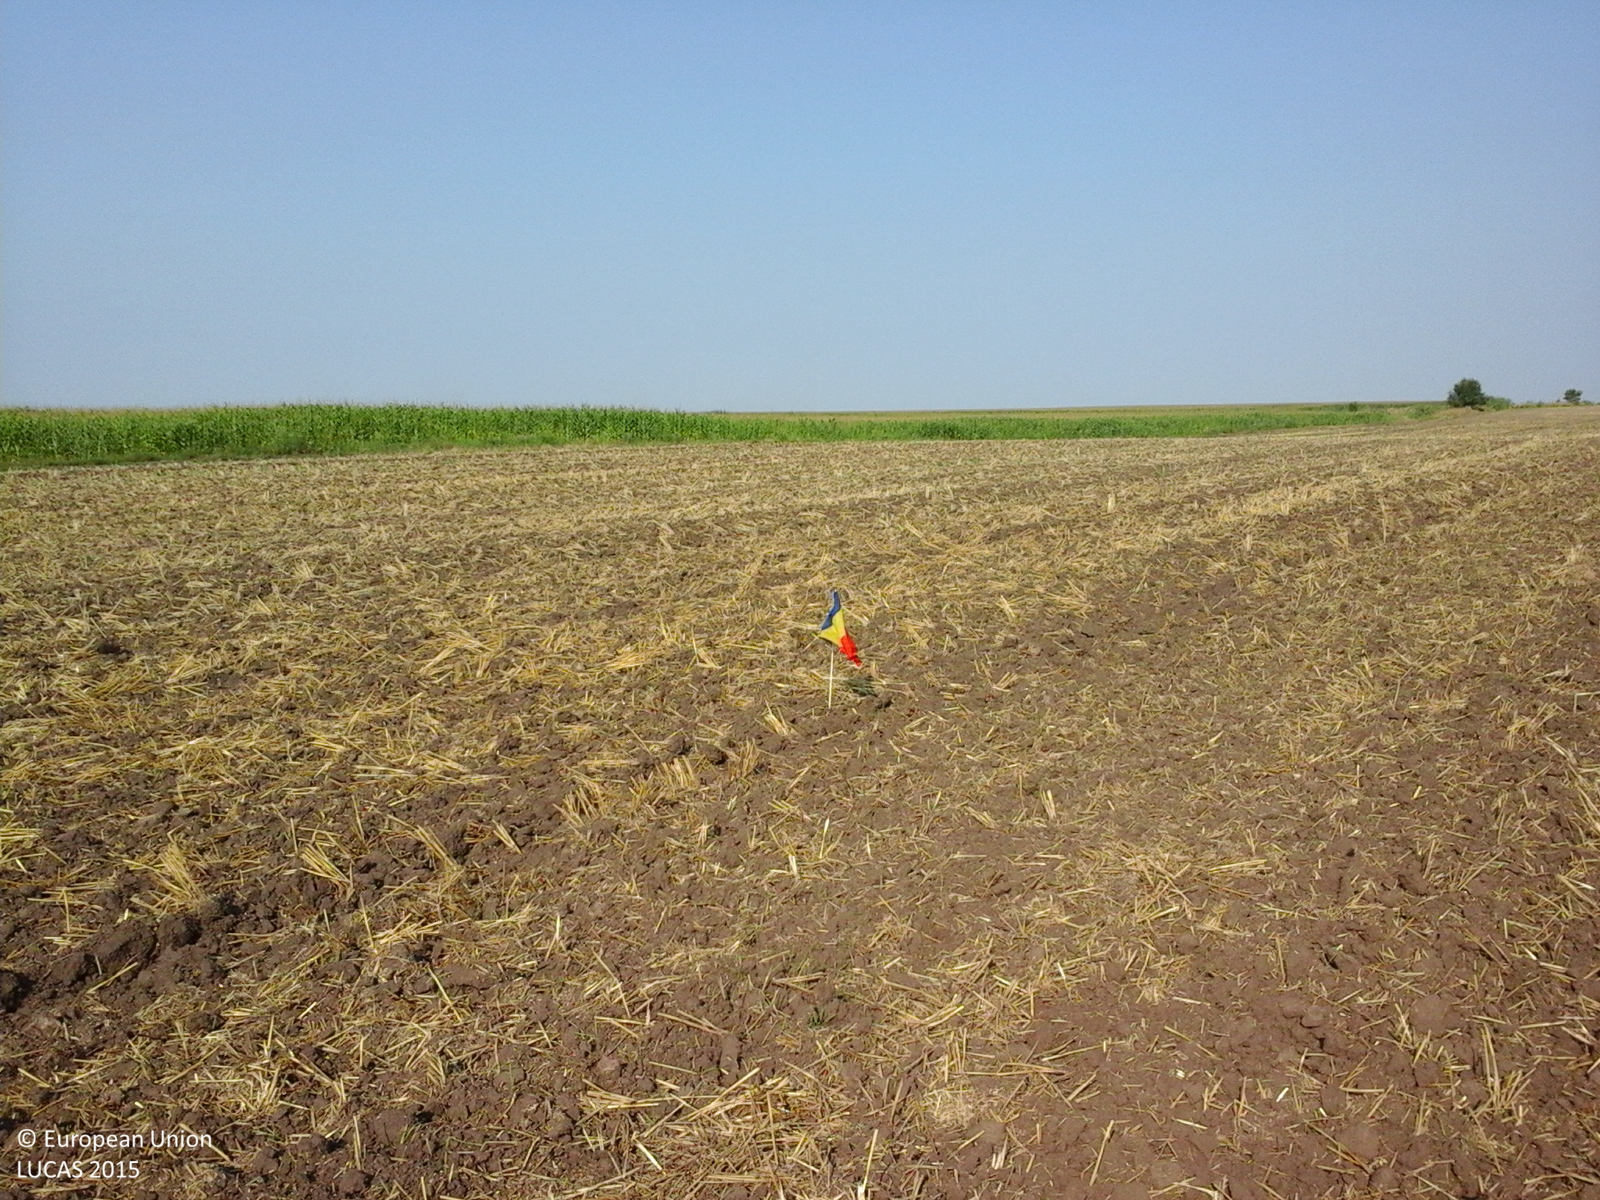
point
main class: Cropland
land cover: Common wheat
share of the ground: < 10 %
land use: Agriculture (excluding fallow land and kitchen gardens)
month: July
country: RO
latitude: 44.8593
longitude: 27.1580
